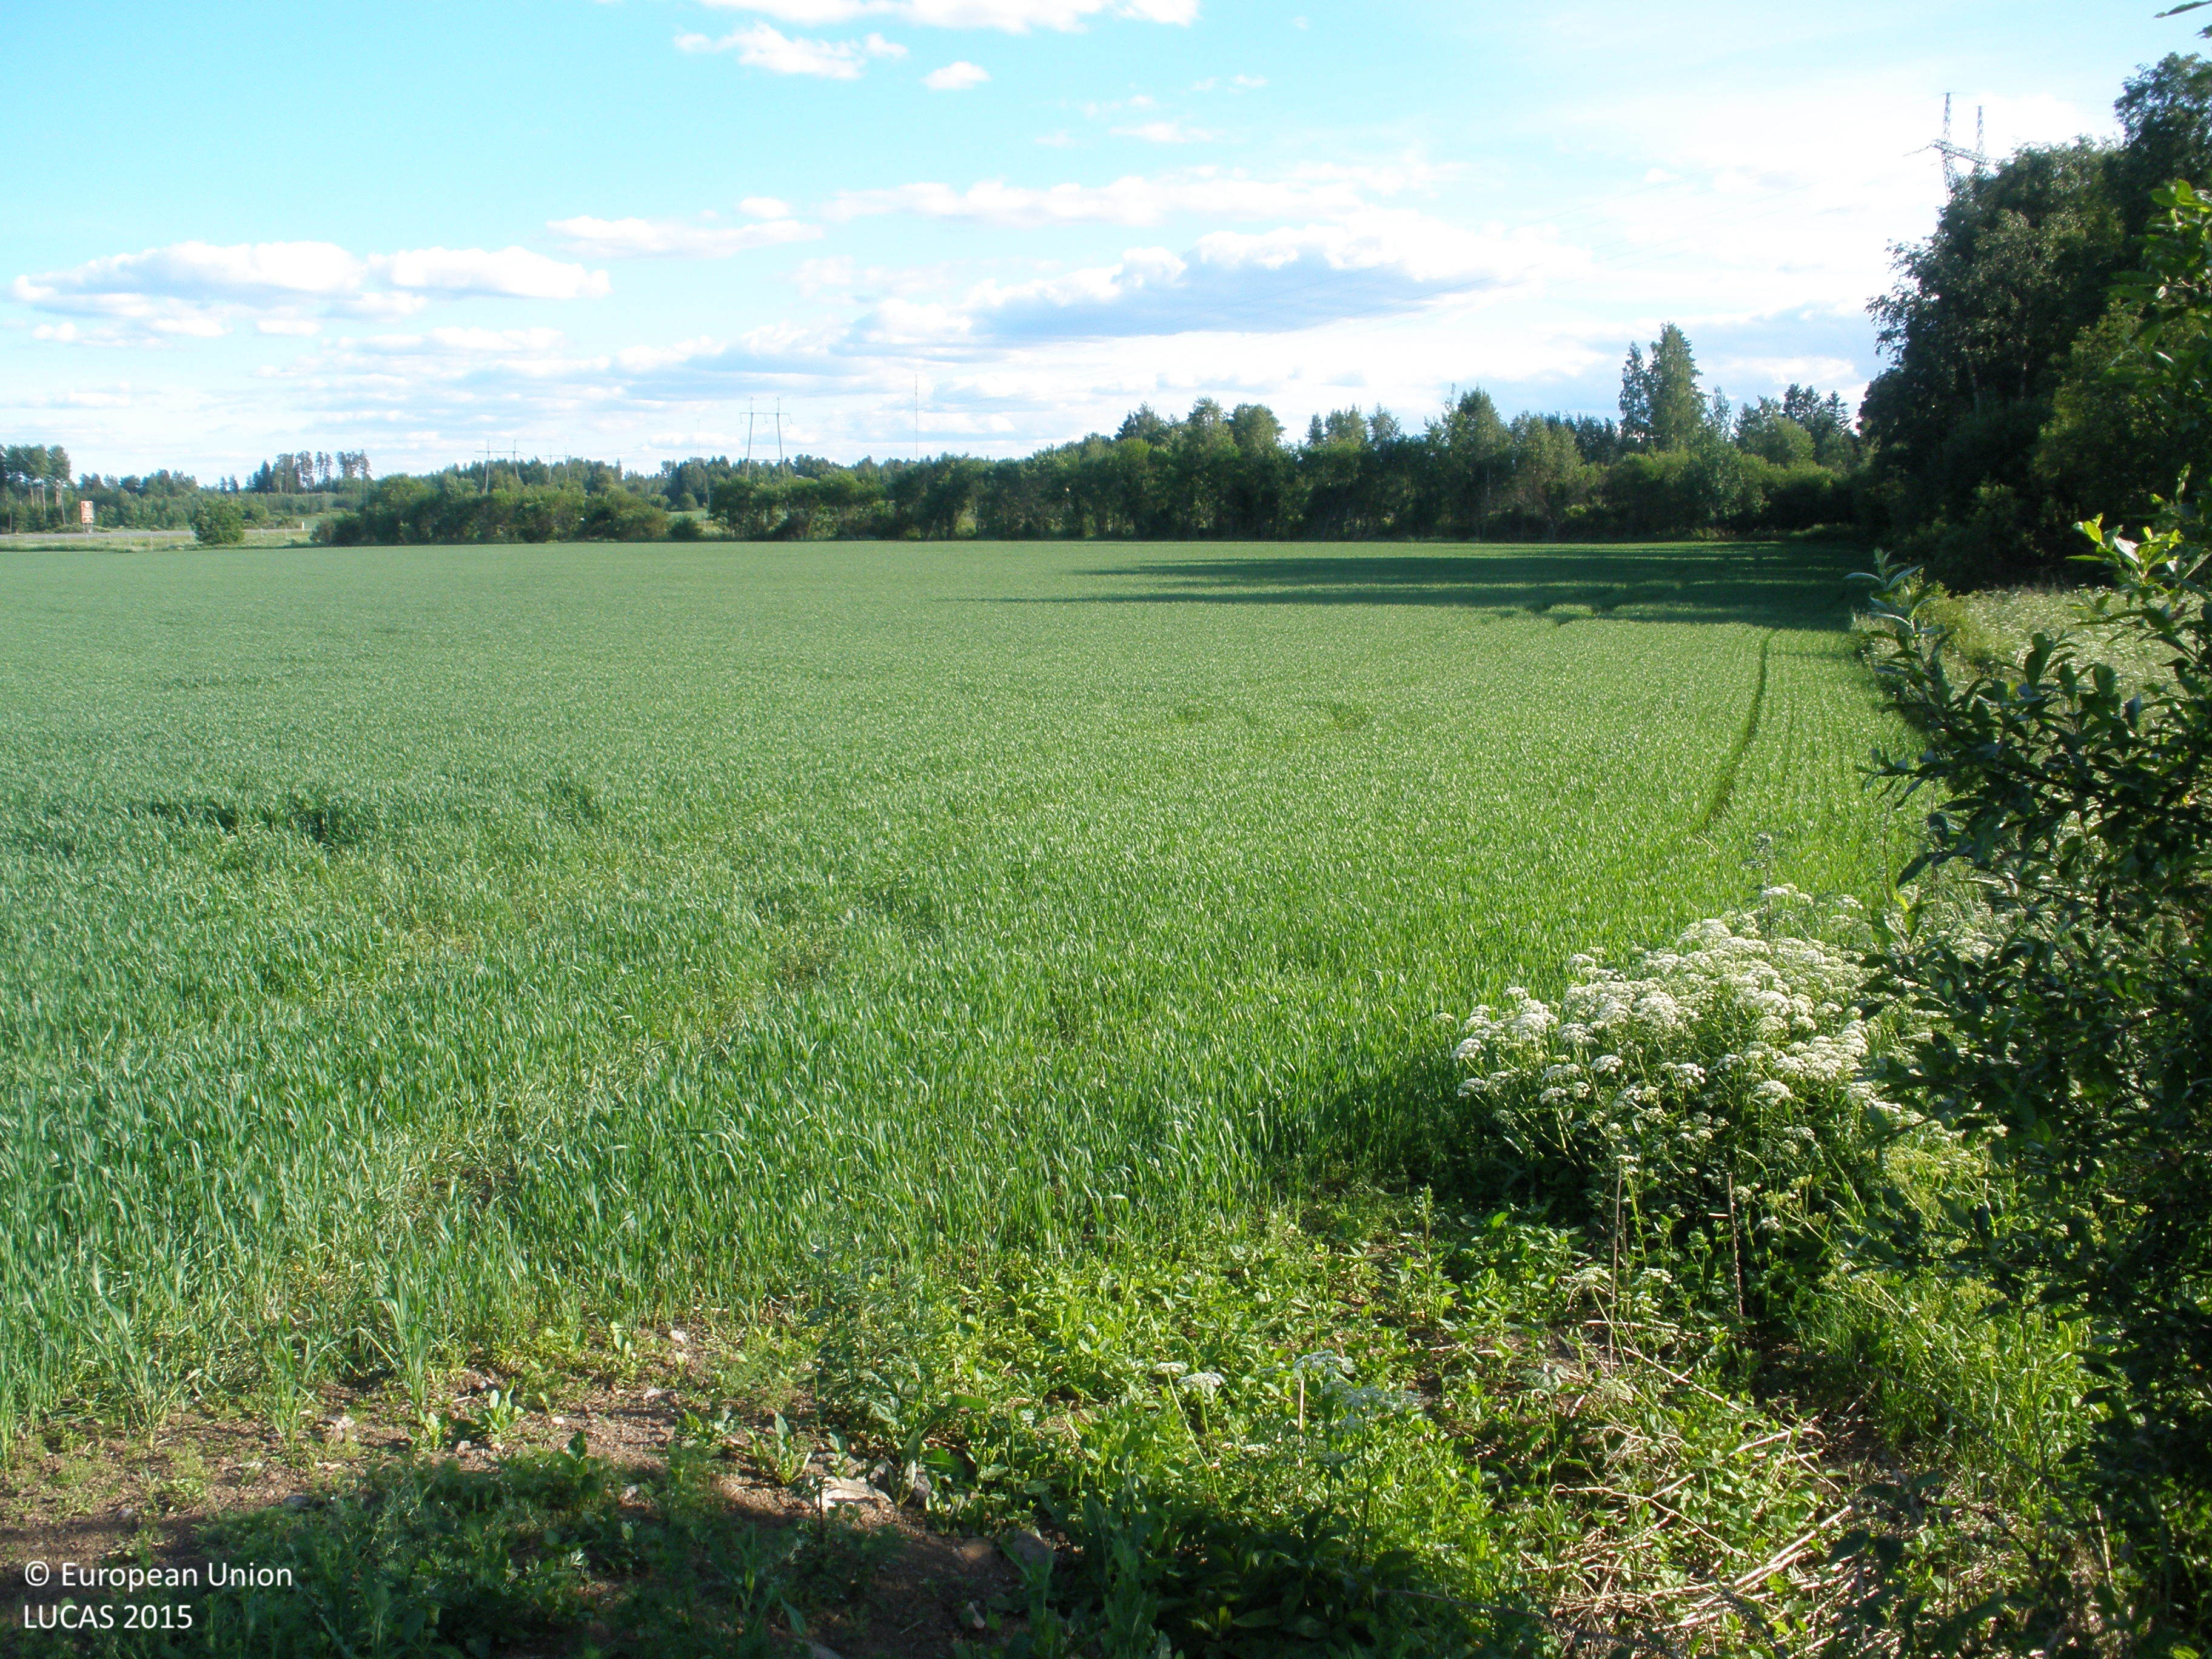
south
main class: Cropland
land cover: Common wheat
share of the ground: > 75 %
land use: Agriculture (excluding fallow land and kitchen gardens)
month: July
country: FI
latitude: 61.1704
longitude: 23.9399
